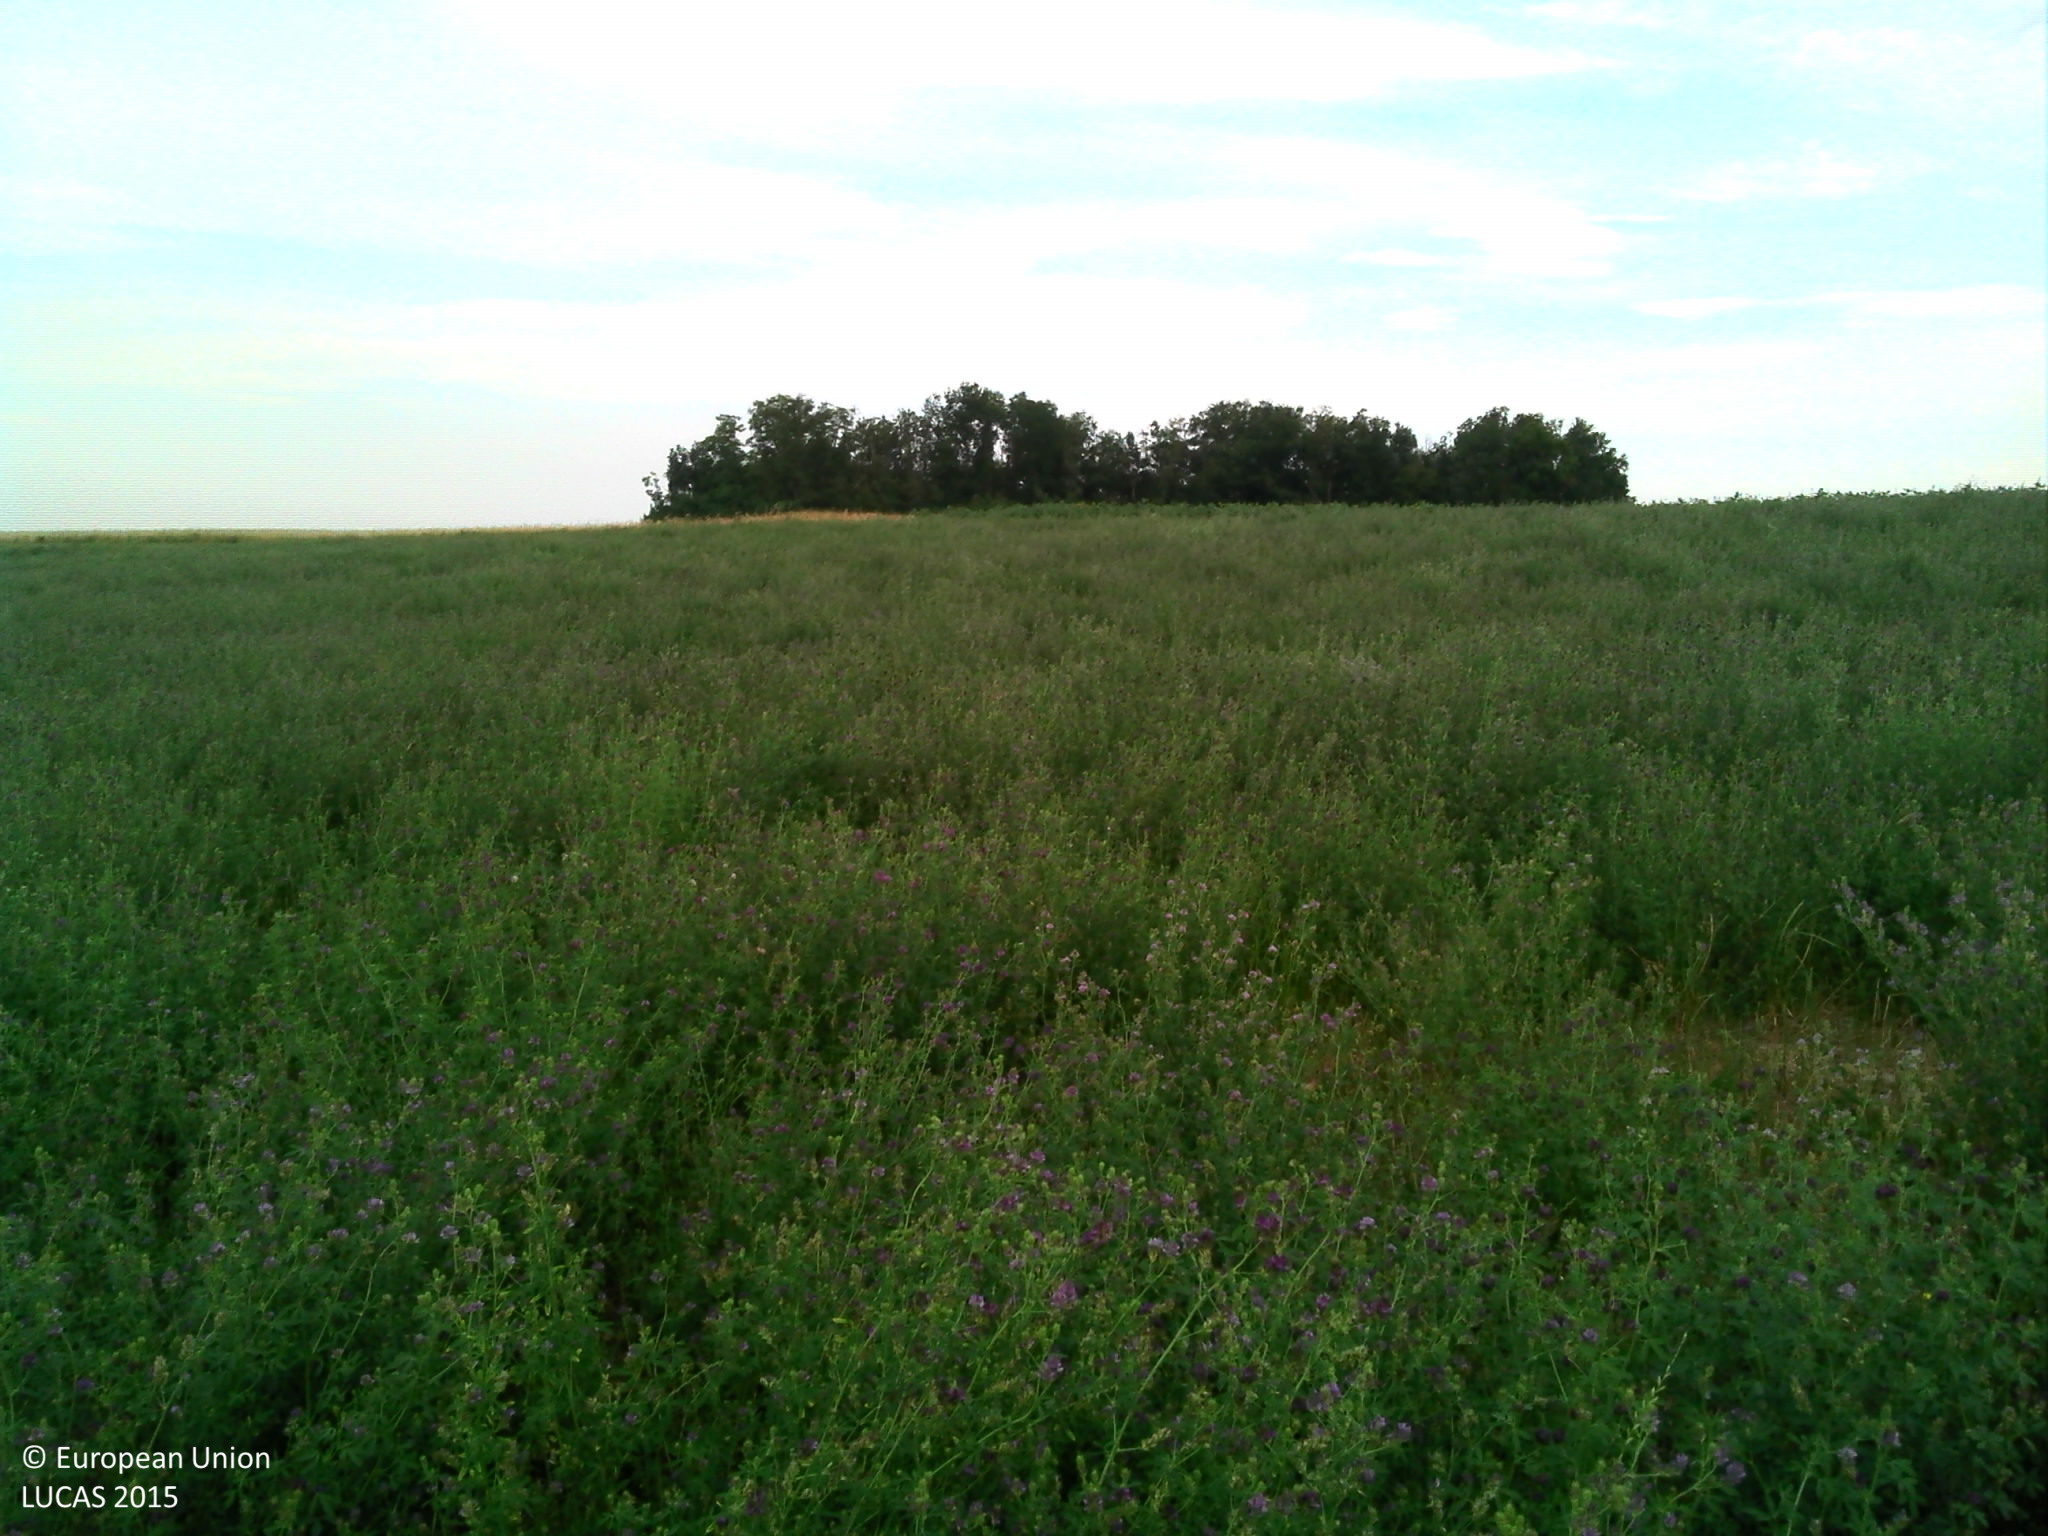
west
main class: Cropland
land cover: Lucerne
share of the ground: > 75 %
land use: Agriculture (excluding fallow land and kitchen gardens)
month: July
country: FR
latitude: 44.3470
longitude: 0.8758
